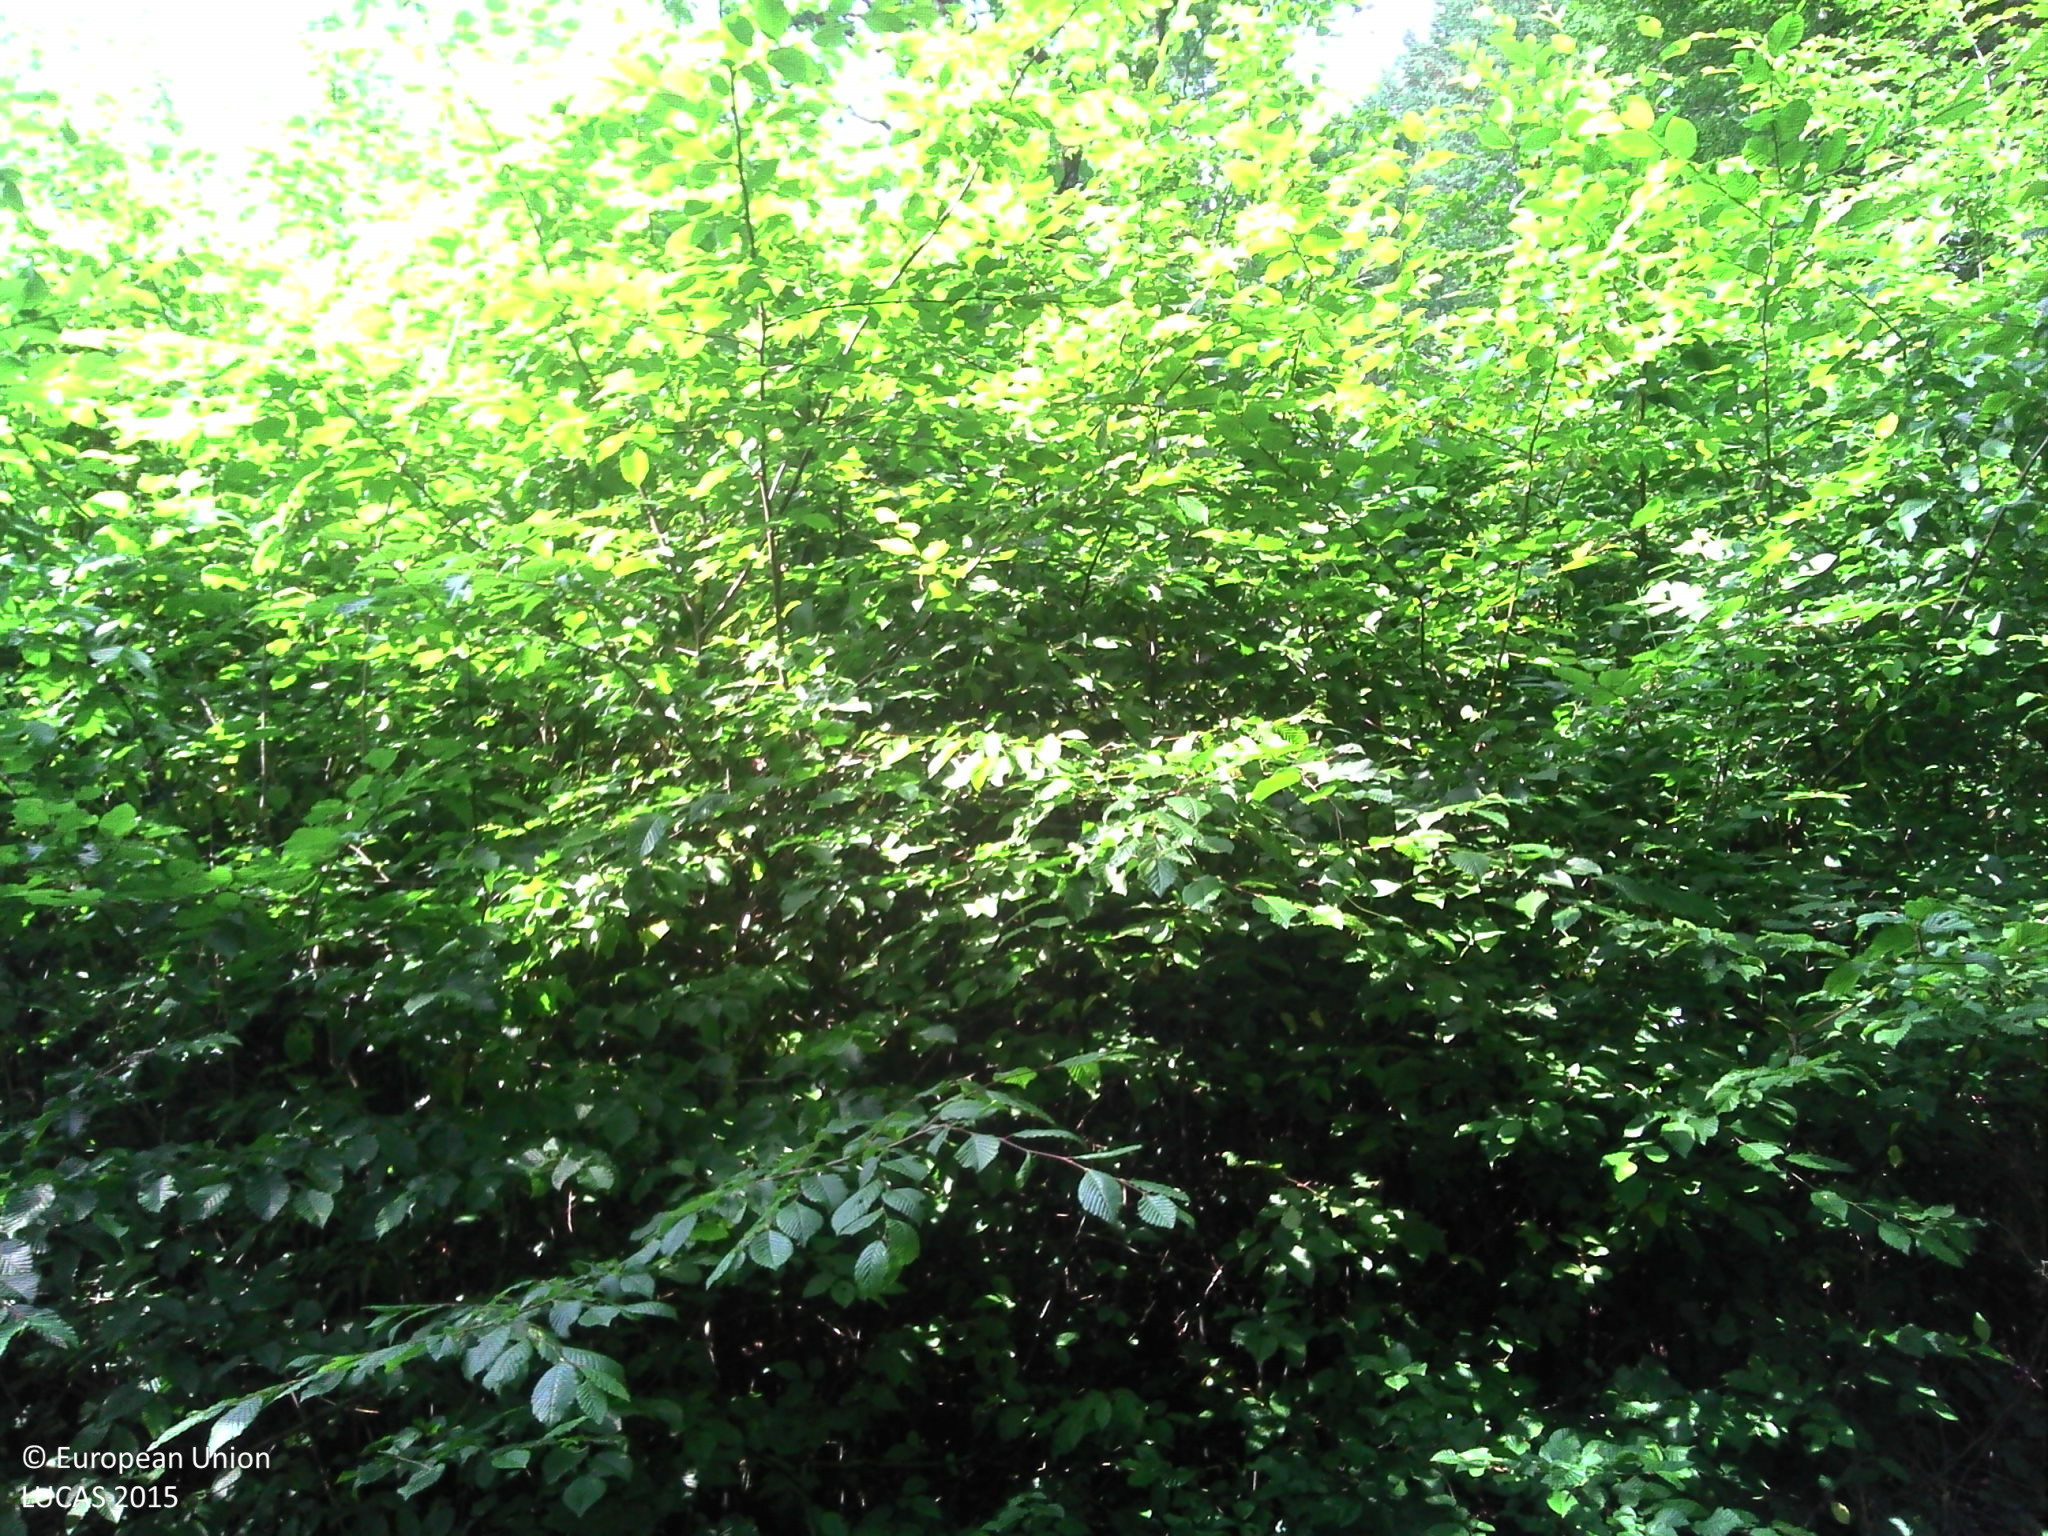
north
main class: Woodland
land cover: Broadleaved woodland
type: mesophytic deciduous forest
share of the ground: > 75 %
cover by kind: broadleaved forest trees 65 %, coniferous forest trees 20 %, herbaceous plants 15 %
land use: Forestry
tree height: > 5 m
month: June
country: FR
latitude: 46.4827
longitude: 4.5435
